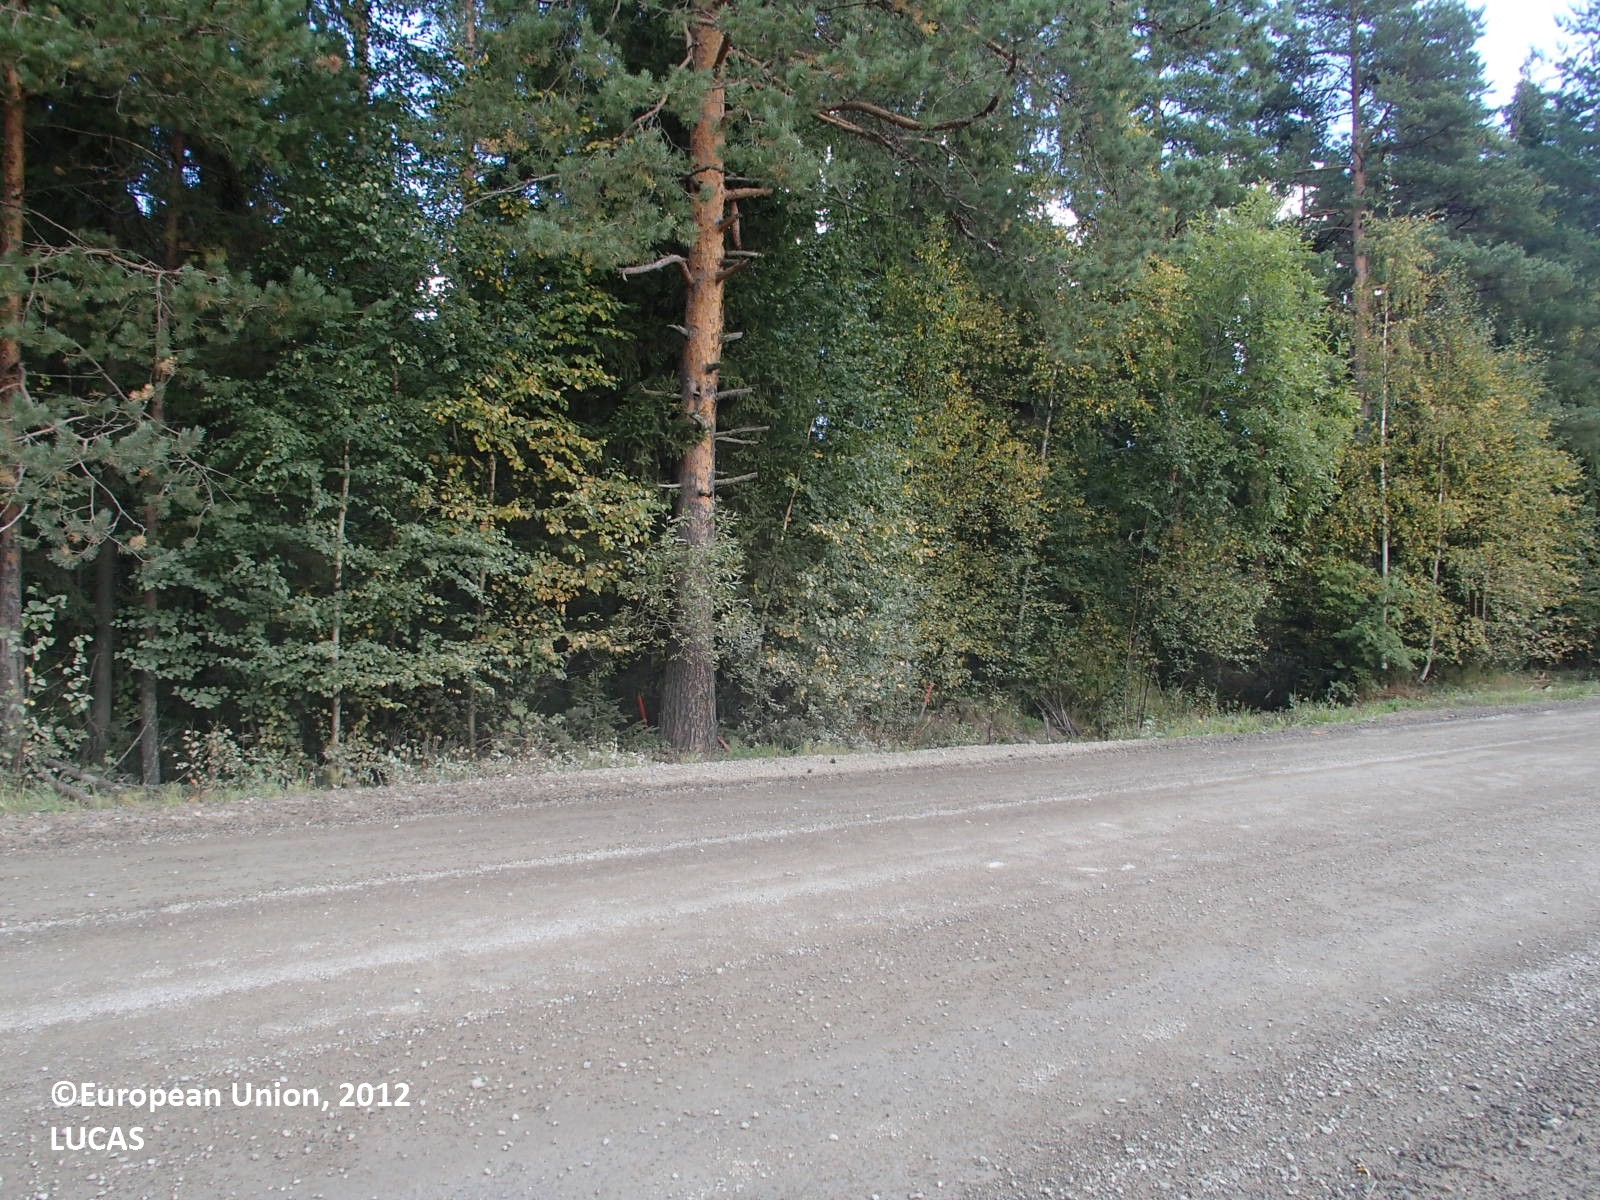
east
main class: Woodland
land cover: Broadleaved woodland
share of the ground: > 75 %
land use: Forestry
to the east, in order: Broadleaved woodland; Ditches and canals; Broadleaved woodland; Ditches and canals; Pine dominated mixed woodland; Ditches and canals; Grass margins; Paved roads, cycling and walking lanes; Grass margins; Ditches and canals; Pine dominated mixed woodland; Ditches and canals; Pine dominated mixed woodland; Spruce dominated mixed woodland; Inland marshes; Inland water bodies
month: August
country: FI
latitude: 63.5291
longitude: 26.9701
